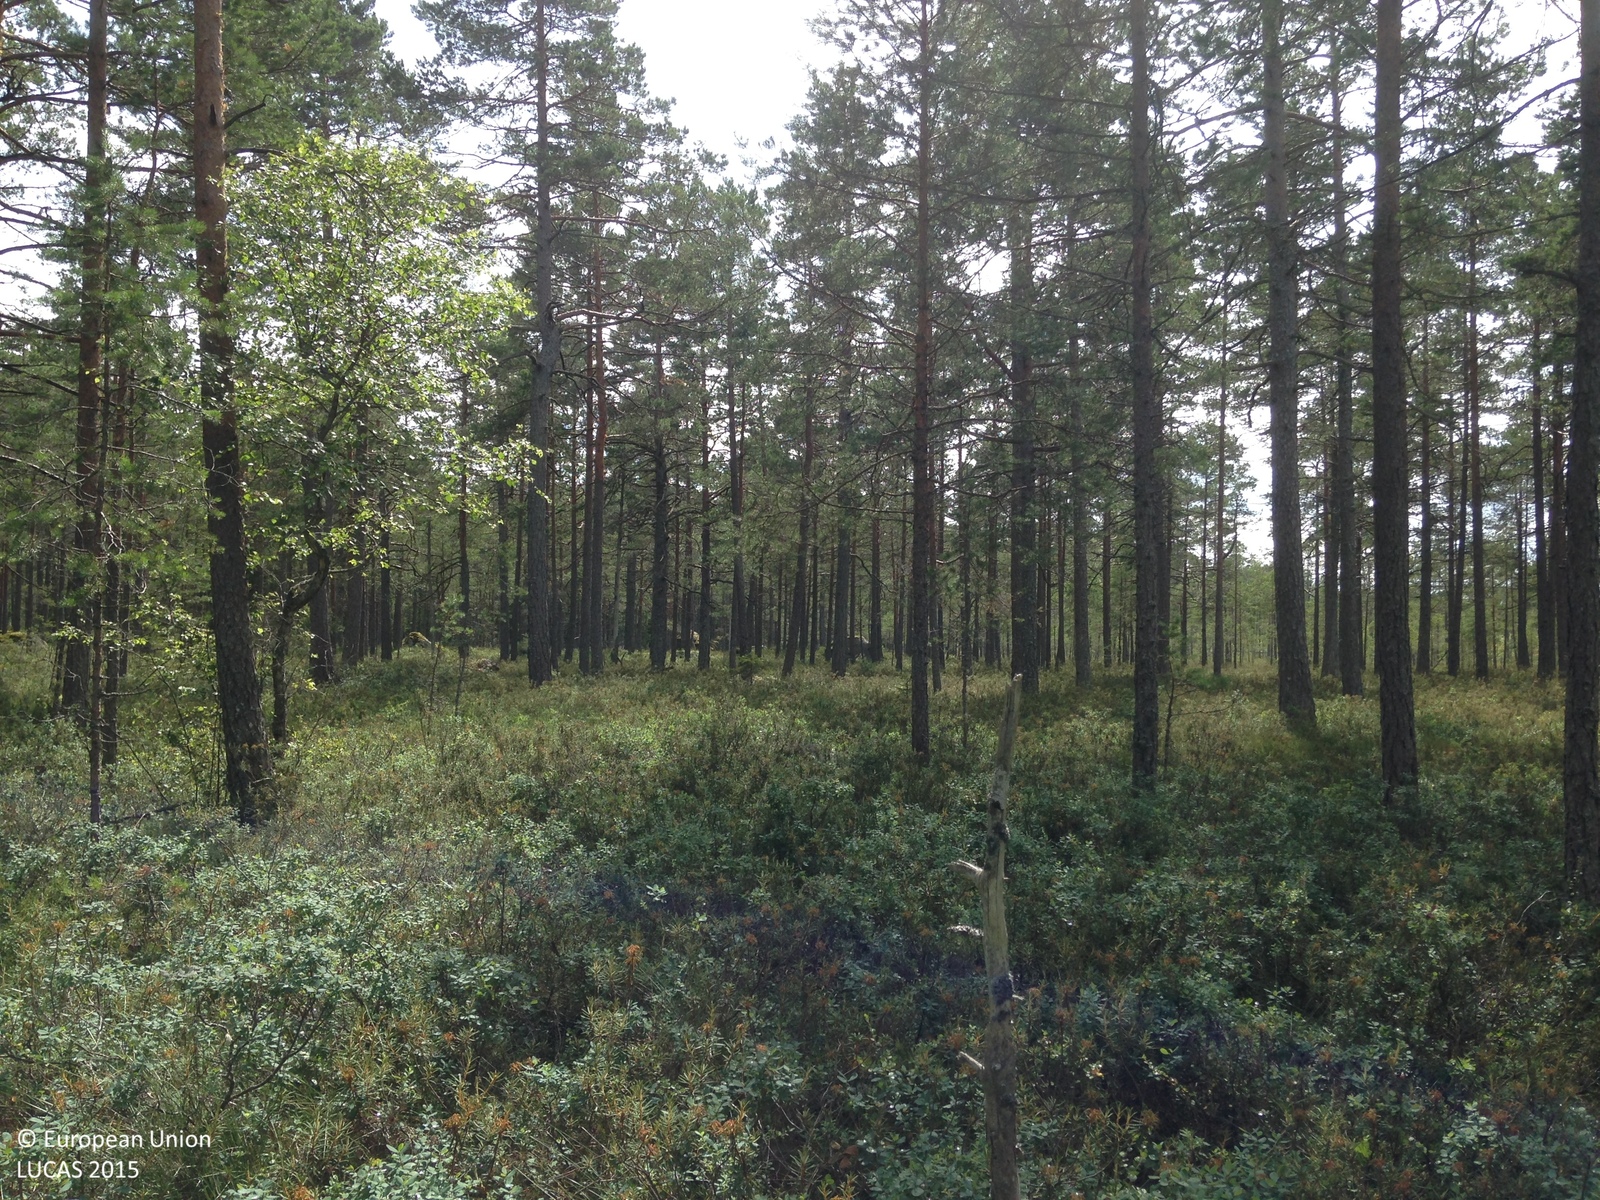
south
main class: Woodland
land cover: Pine dominated coniferous woodland
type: boreal forest
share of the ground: 10 - 25 %
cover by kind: shrubs 50 %, coniferous forest trees 20 %, lichens and mosses 20 %, herbaceous plants 10 %
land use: Forestry
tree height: > 5 m
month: July
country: SE
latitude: 58.9744
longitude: 14.4627
